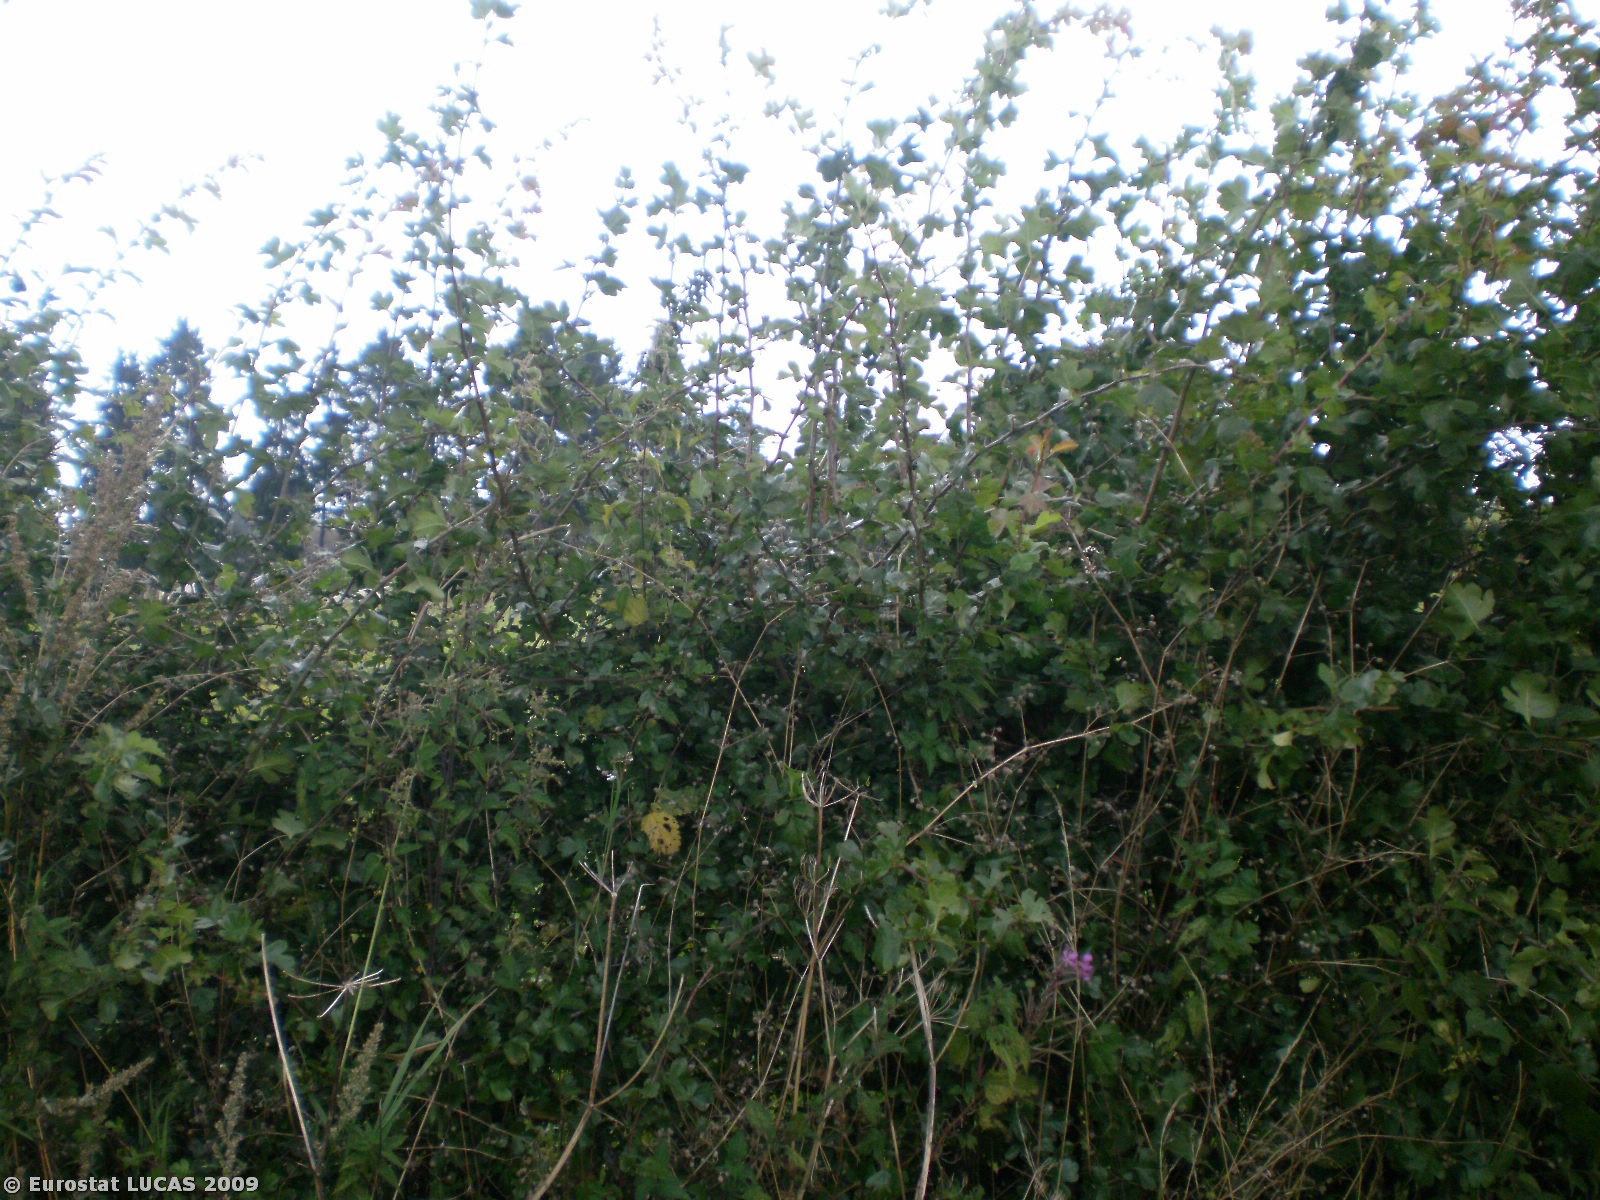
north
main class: Grassland
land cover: Grassland without tree/shrub cover
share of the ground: > 75 %
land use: Agriculture (excluding fallow land and kitchen gardens)
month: September
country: BE
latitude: 50.4113
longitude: 6.2703
